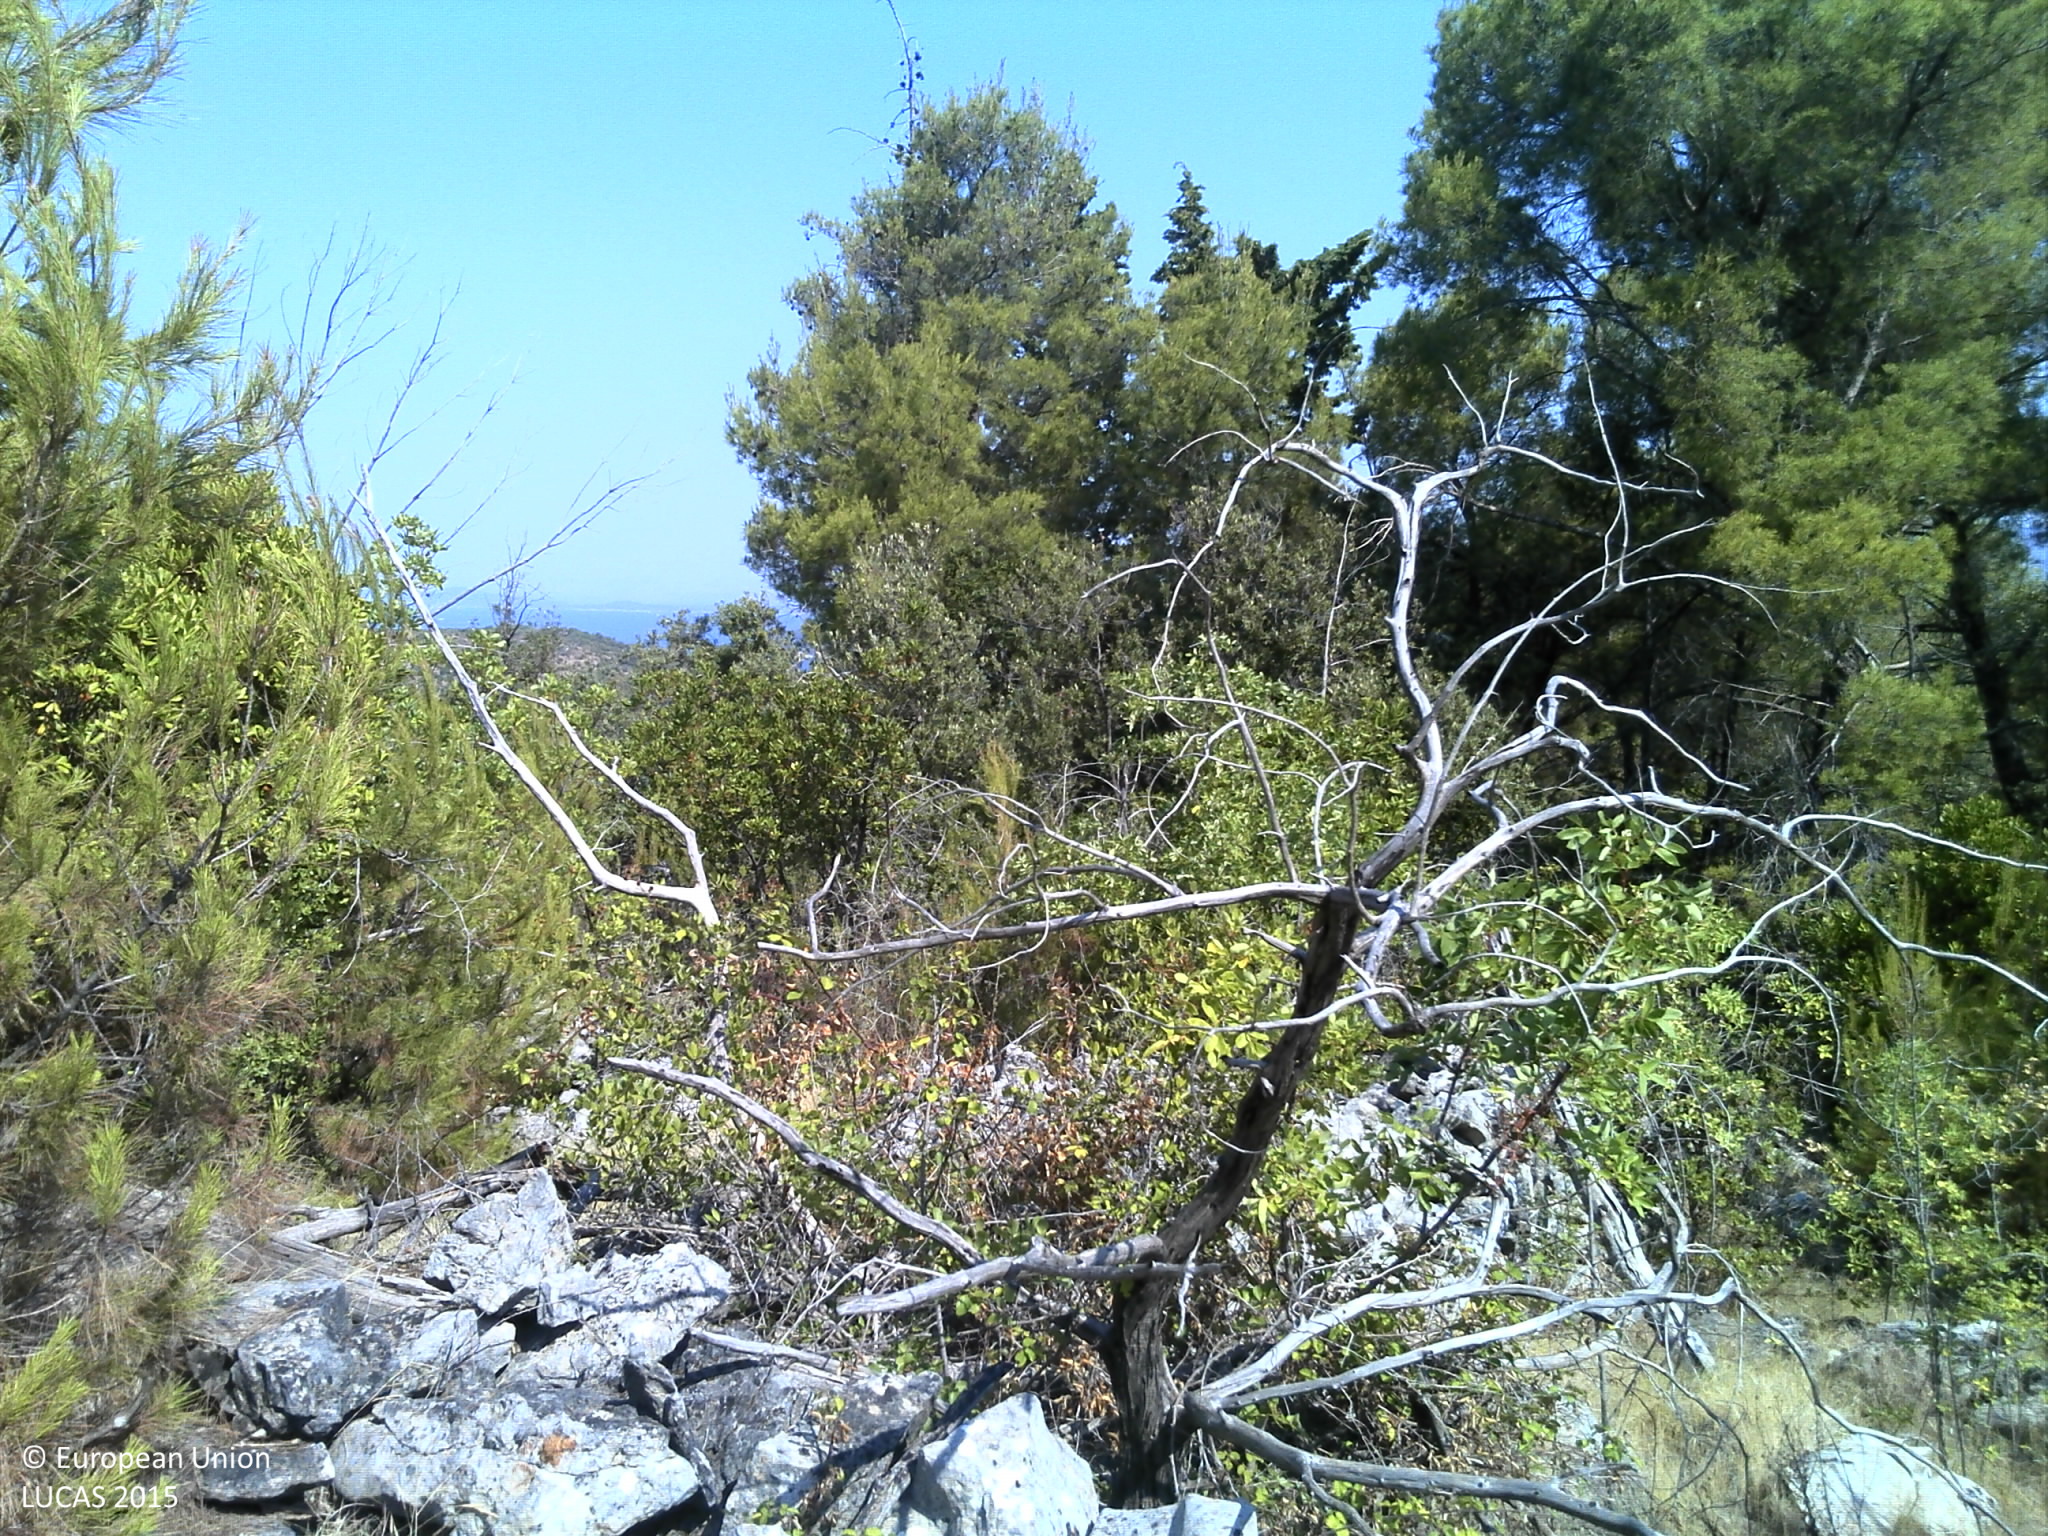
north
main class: Shrubland
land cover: Shrubland with sparse tree cover
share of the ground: > 75 %
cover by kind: shrubs 75 %, herbaceous plants 10 %, coniferous forest trees 5 %, consolidated bare surface 5 %, unconsolidated bare surface 5 %
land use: Semi-natural and natural areas not in use
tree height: > 5 m
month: August
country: HR
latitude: 43.1650
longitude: 16.5698
